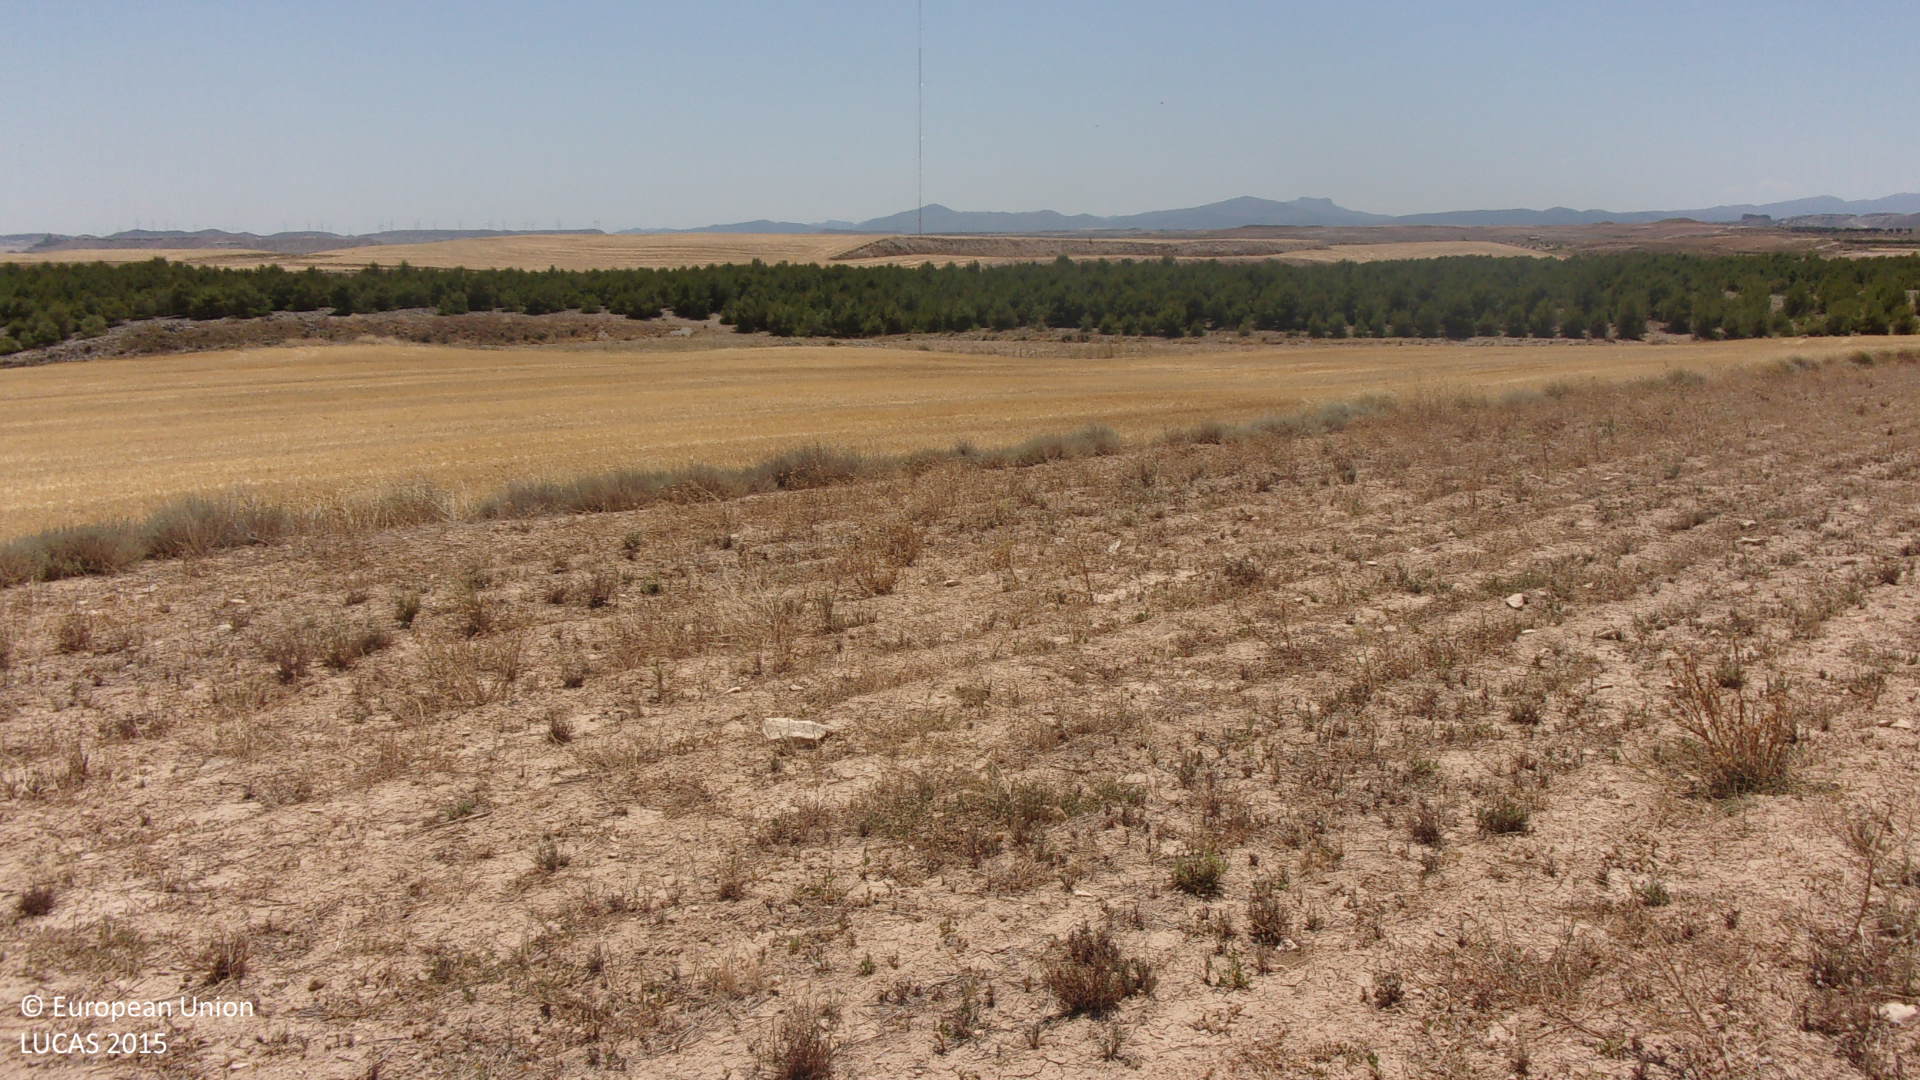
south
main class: Grassland
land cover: Spontaneously vegetated surfaces
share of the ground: 25 - 50 %
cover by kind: unconsolidated bare surface 65 %, herbaceous plants 35 %
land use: Fallow land
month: July
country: ES
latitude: 41.8885
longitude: -1.4904
